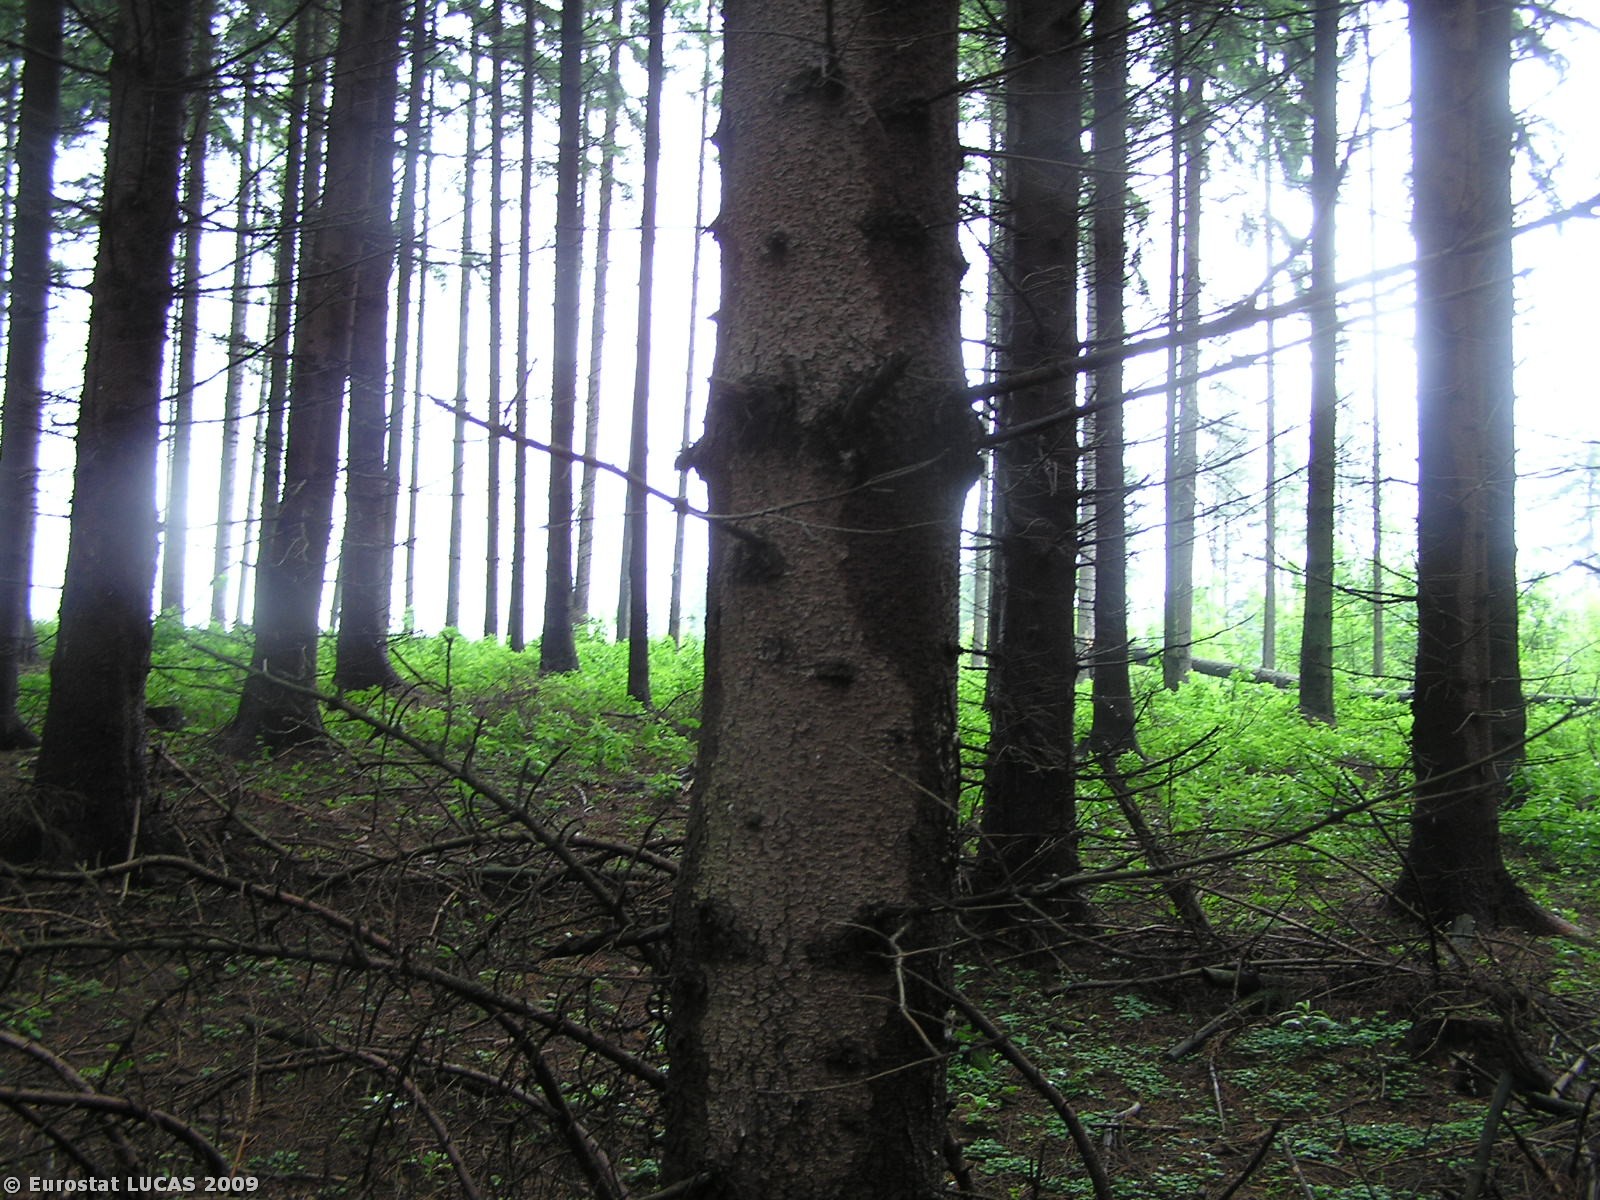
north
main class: Woodland
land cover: Coniferous woodland
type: hemiboreal forest and nemoral coniferous forest and mixed broadleaved-coniferous forest
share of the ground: > 75 %
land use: Forestry
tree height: > 5 m
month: May
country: CZ
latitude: 50.1395
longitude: 17.4418
